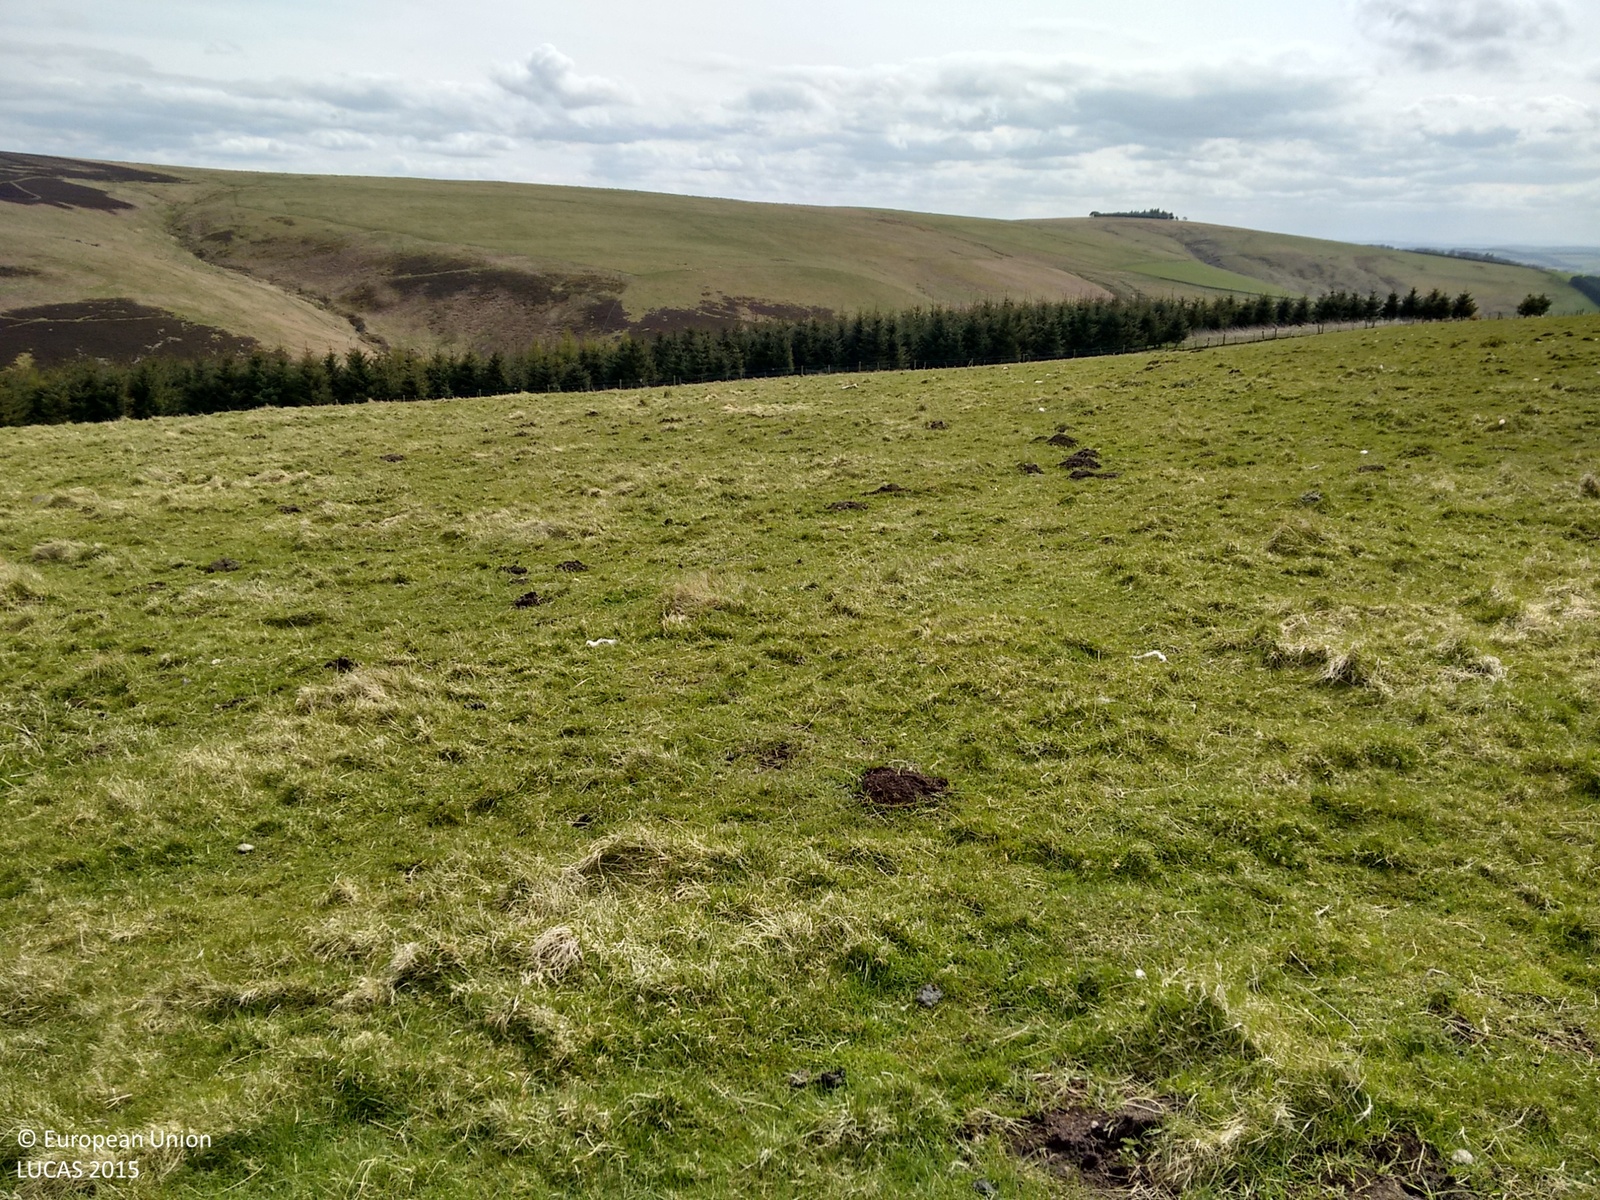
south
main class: Grassland
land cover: Grassland without tree/shrub cover
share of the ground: > 75 %
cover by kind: herbaceous plants 100 %
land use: Agriculture (excluding fallow land and kitchen gardens)
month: May
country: GB
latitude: 55.7862
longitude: -2.7417
